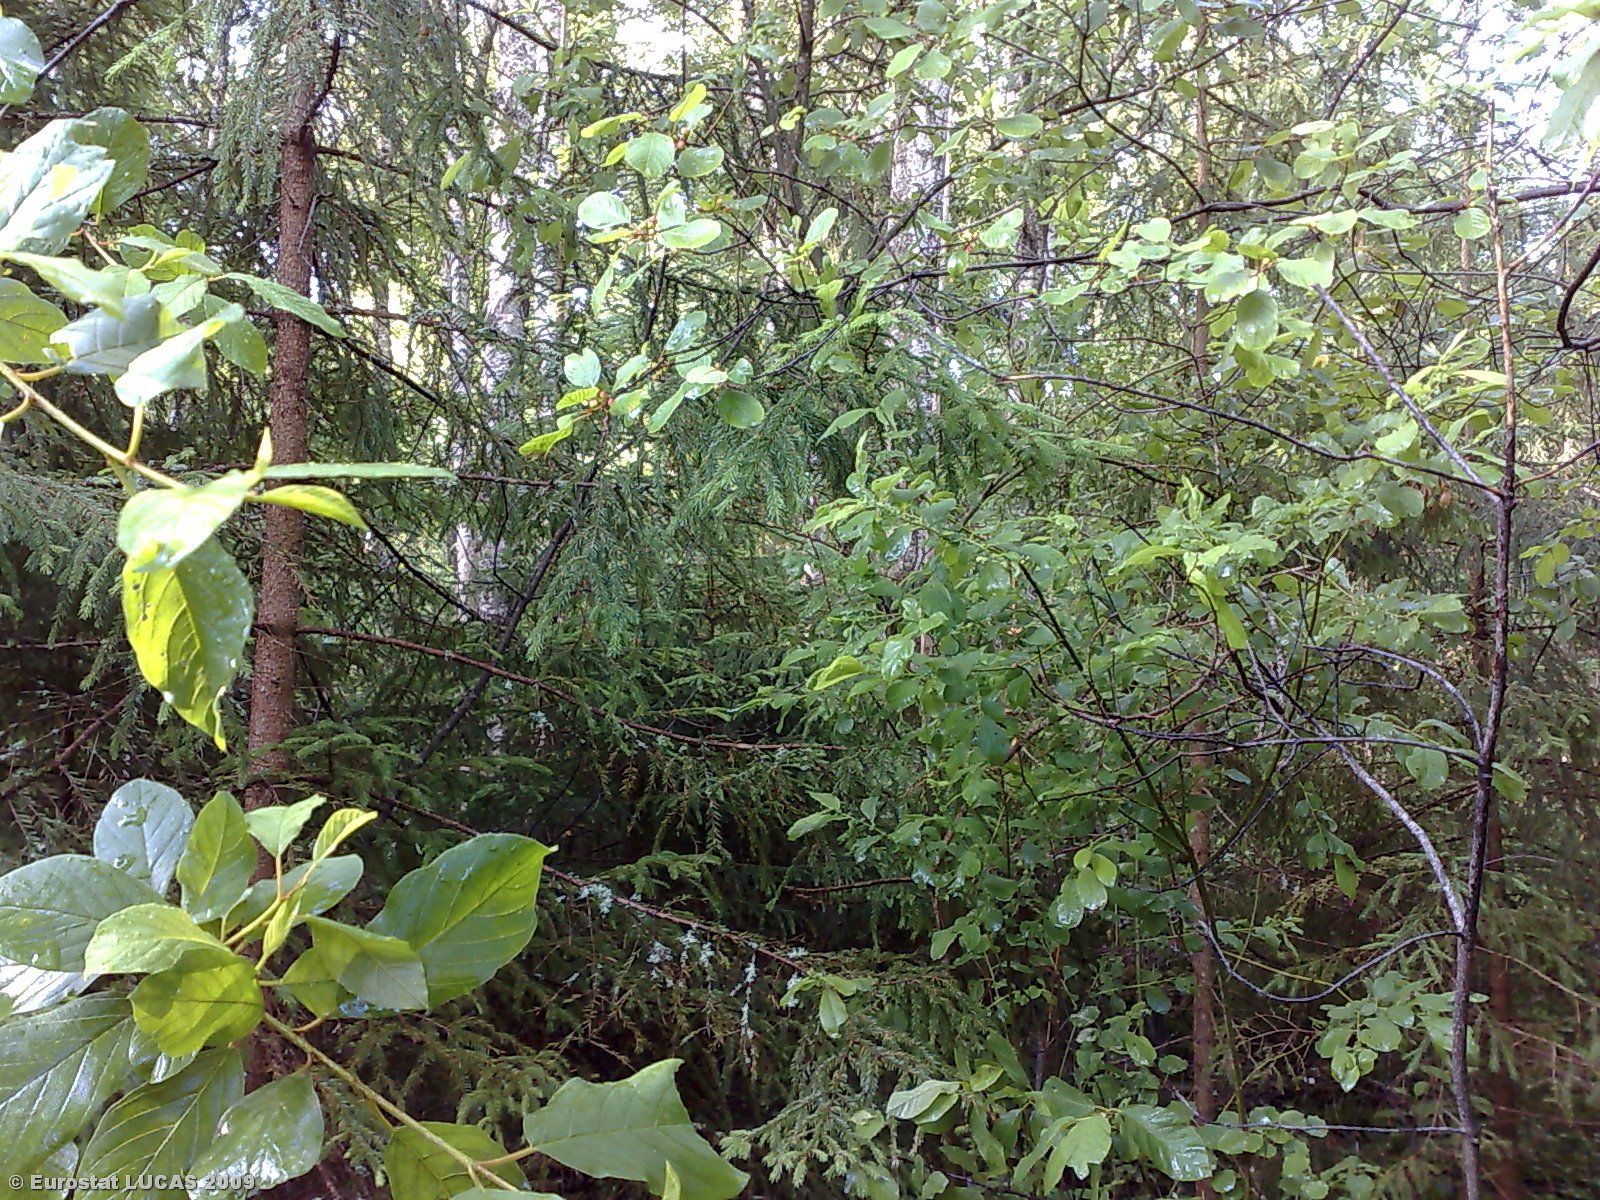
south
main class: Woodland
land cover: Mixed woodland
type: hemiboreal forest and nemoral coniferous forest and mixed broadleaved-coniferous forest
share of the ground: 50 - 75 %
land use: Forestry
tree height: > 5 m
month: July
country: LT
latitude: 55.6853
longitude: 22.8383
